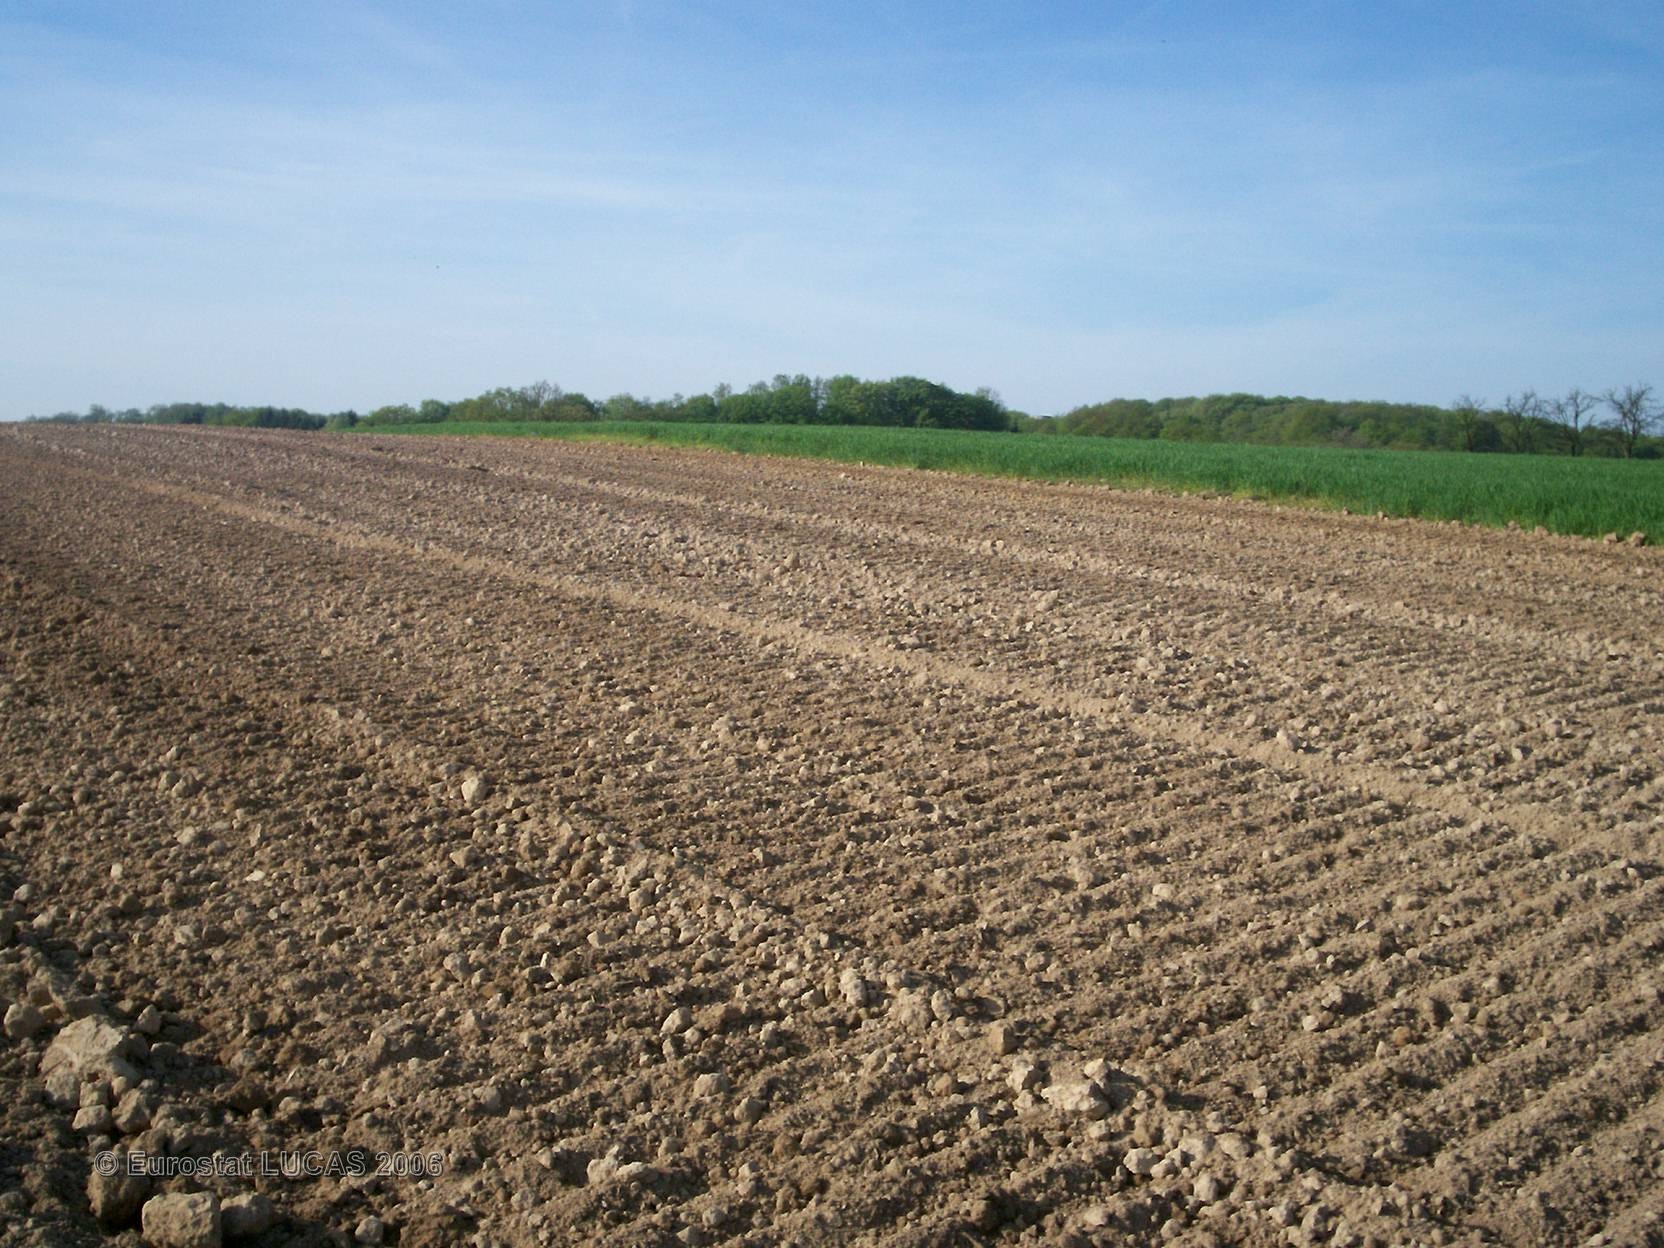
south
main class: Cropland
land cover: Maize
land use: Agriculture (excluding fallow land and kitchen gardens)
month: May
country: FR
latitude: 49.0089
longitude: 6.9243
